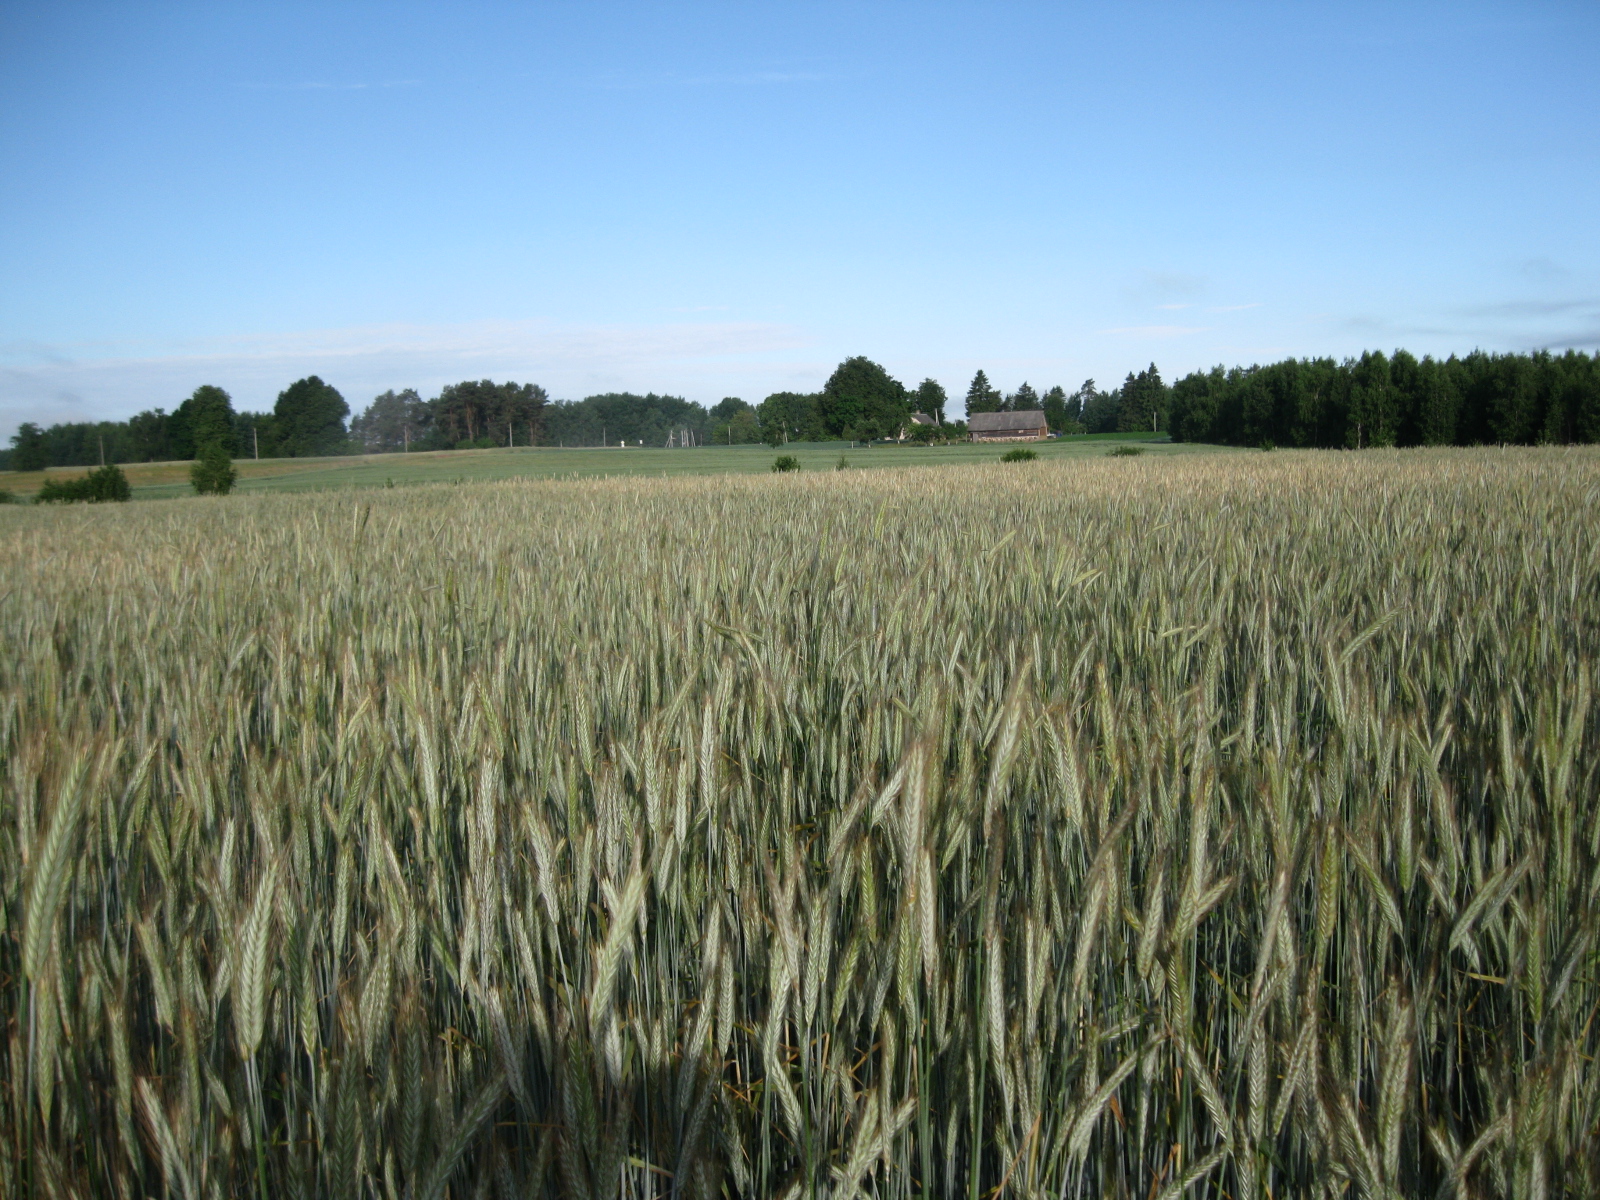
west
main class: Cropland
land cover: Rye
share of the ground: > 75 %
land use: Agriculture (excluding fallow land and kitchen gardens)
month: June
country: LT
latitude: 55.2387
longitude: 24.1046
